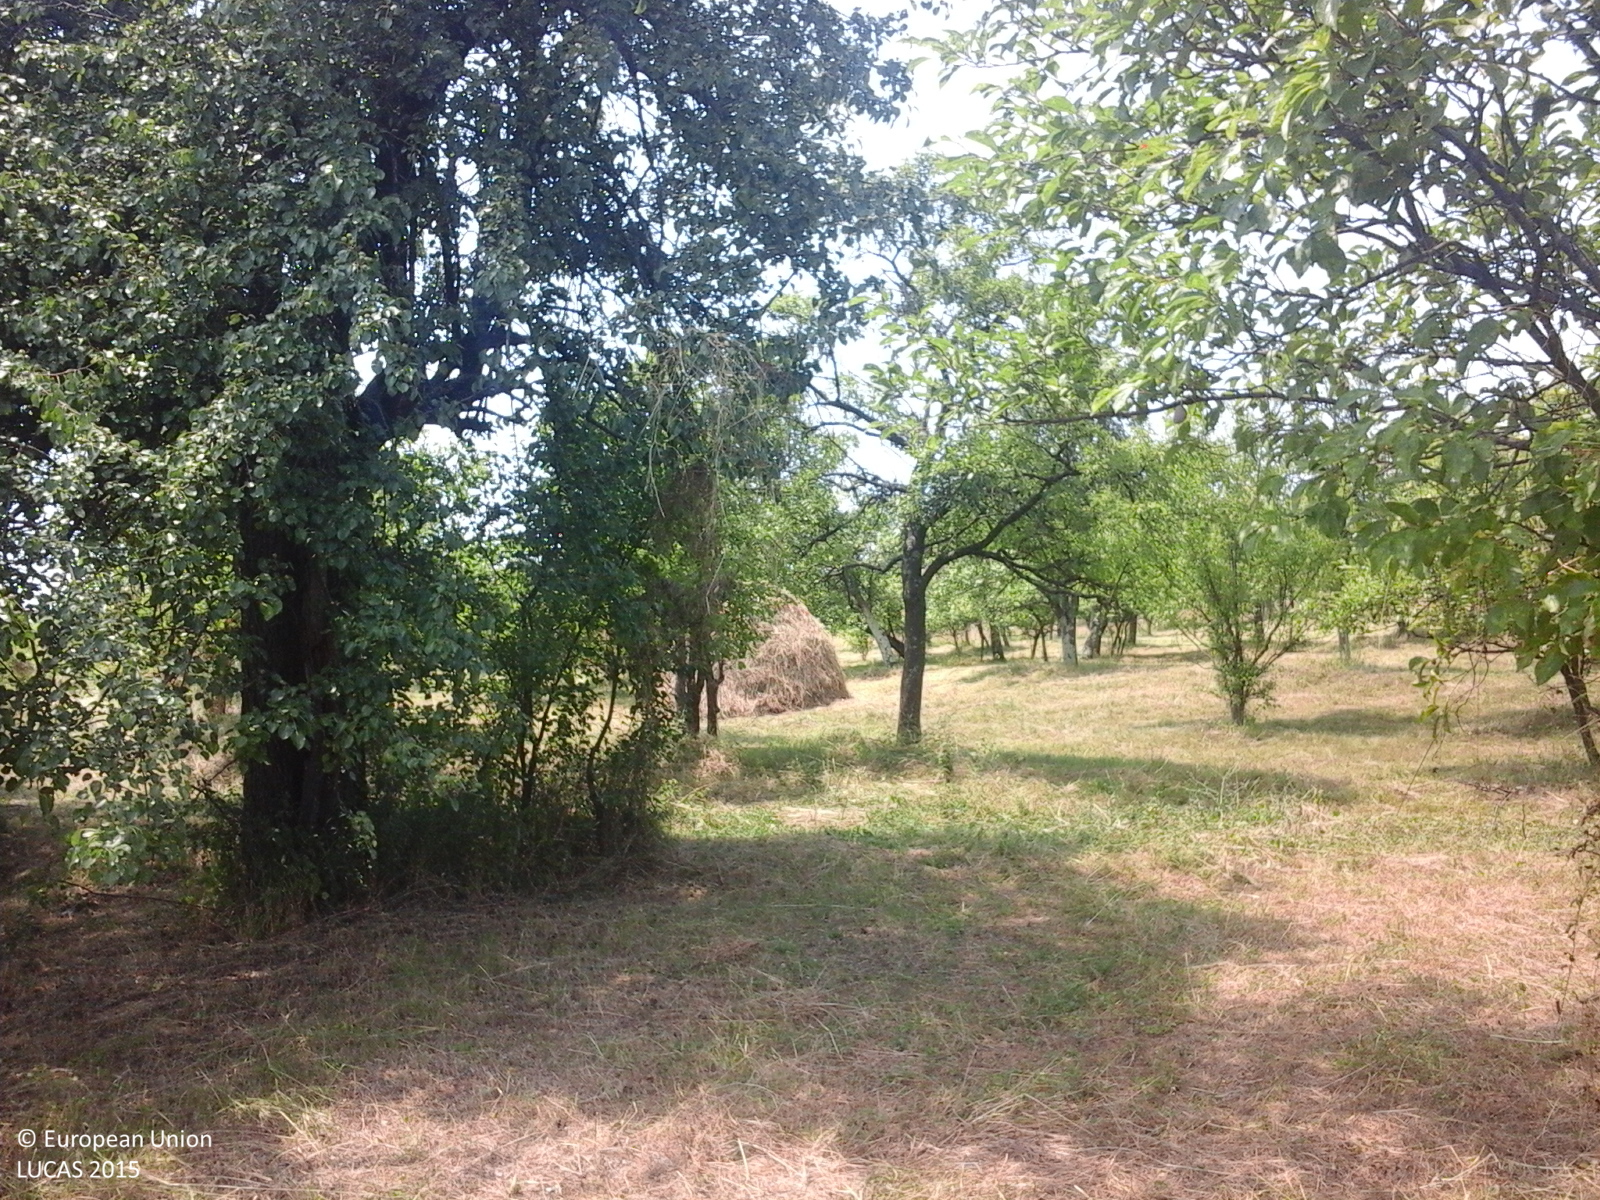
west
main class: Cropland
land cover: Other fruit trees and berries
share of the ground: 25 - 50 %
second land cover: Grassland without tree/shrub cover
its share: > 75 %
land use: Agriculture (excluding fallow land and kitchen gardens)
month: July
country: RO
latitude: 45.0723
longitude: 24.4407
